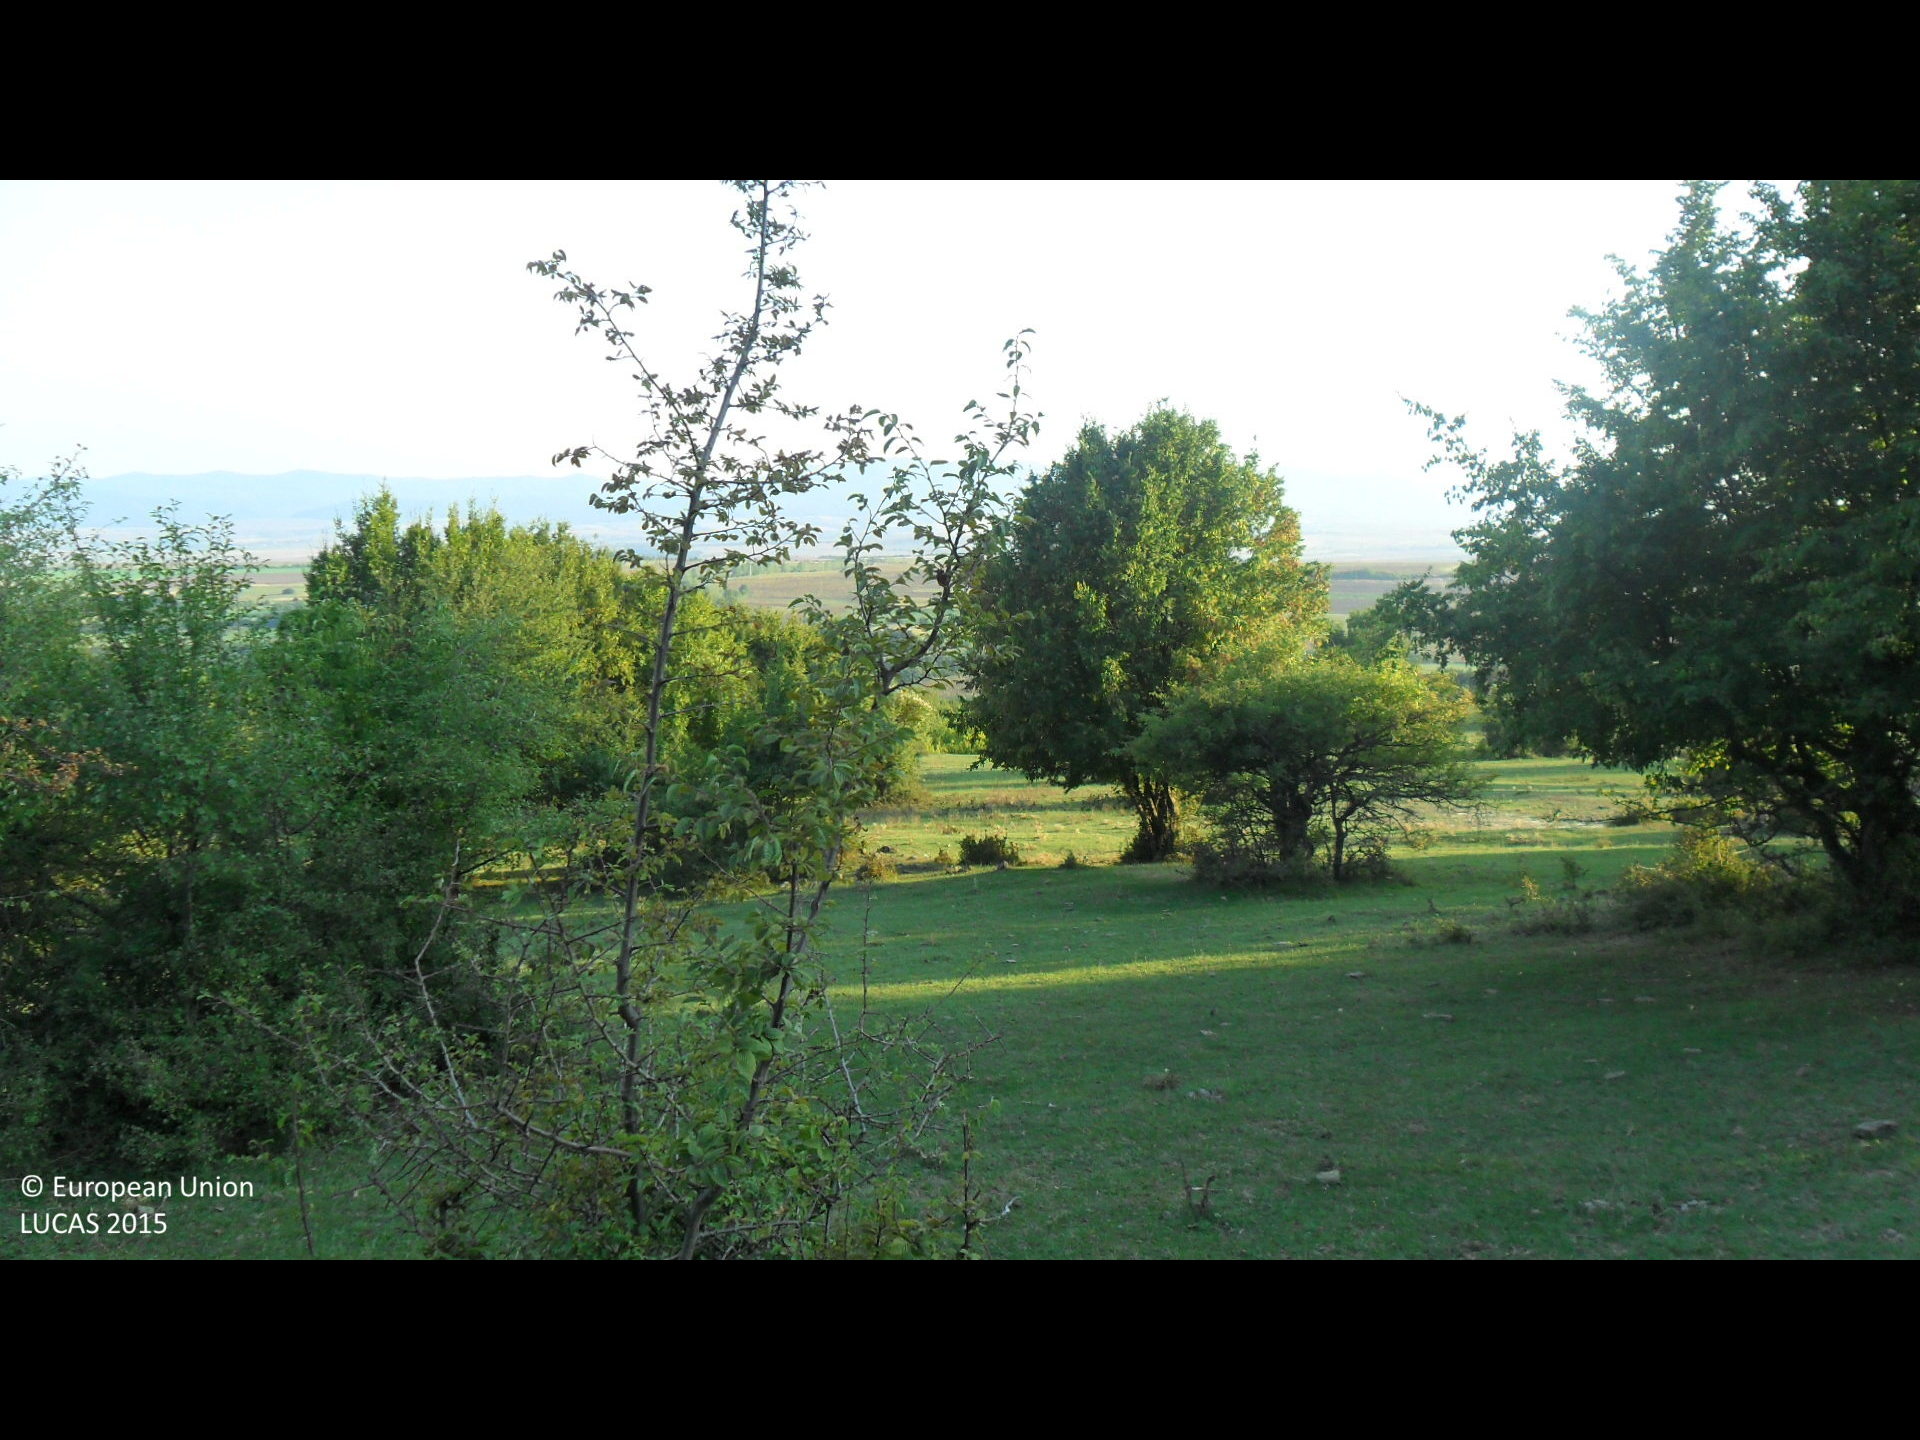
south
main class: Shrubland
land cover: Shrubland with sparse tree cover
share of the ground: 50 - 75 %
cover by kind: shrubs 70 %, herbaceous plants 25 %, broadleaved forest trees 5 %
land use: Agriculture (excluding fallow land and kitchen gardens)
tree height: < 5 m
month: September
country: BG
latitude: 43.0762
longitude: 26.5966
